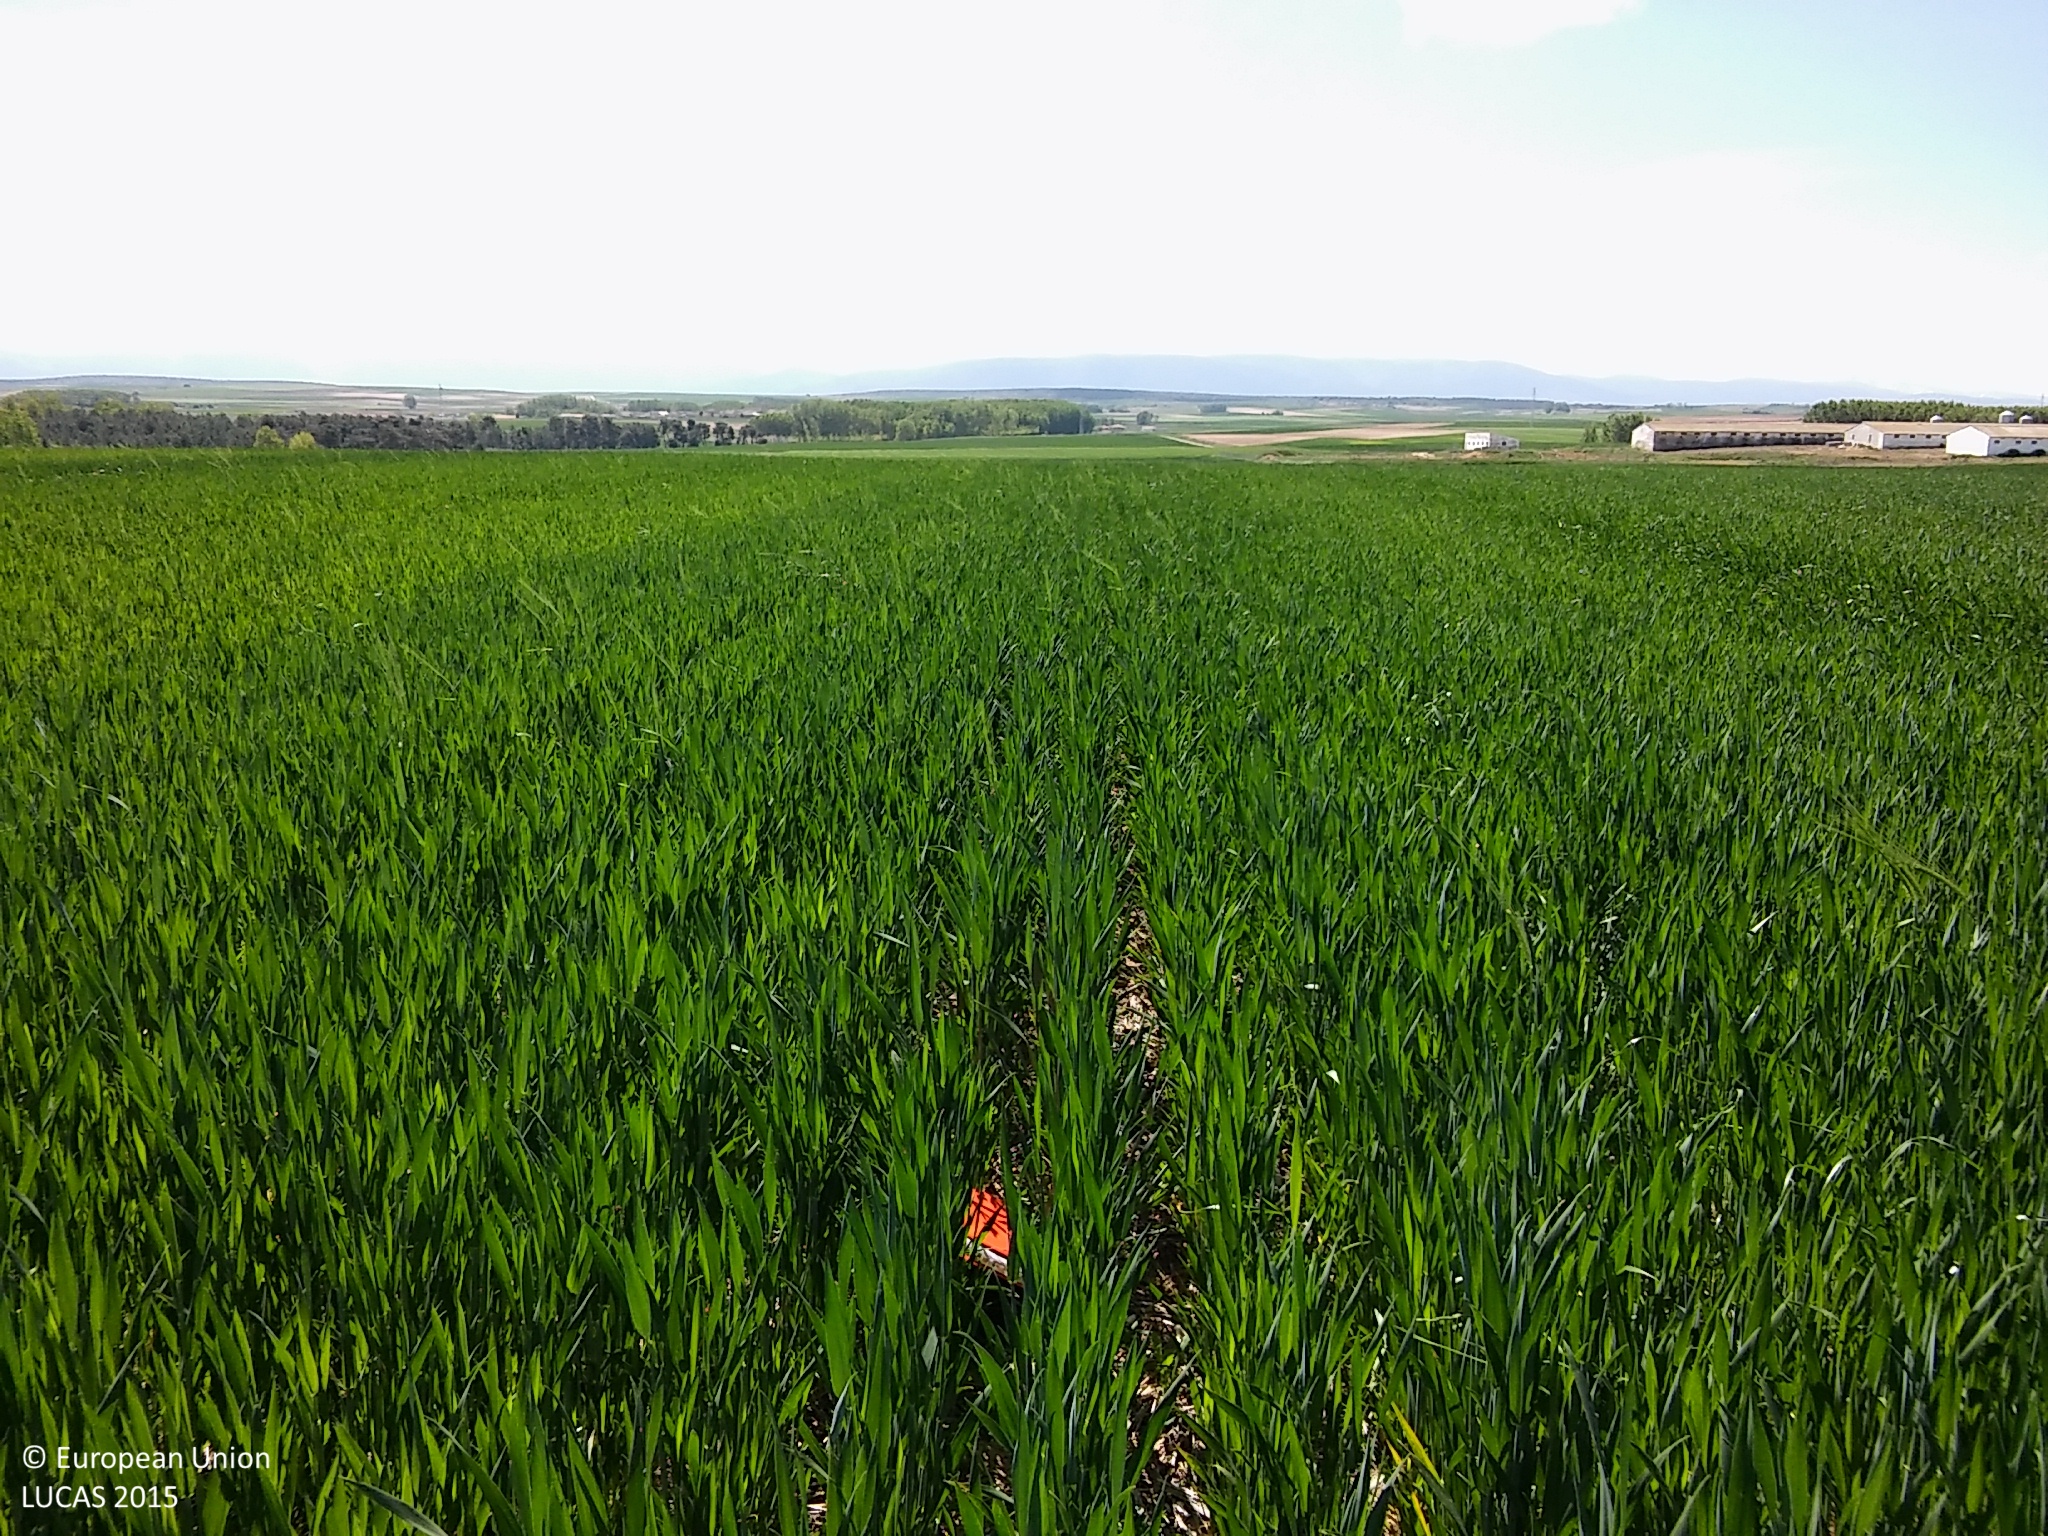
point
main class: Cropland
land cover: Common wheat
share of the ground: > 75 %
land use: Agriculture (excluding fallow land and kitchen gardens)
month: May
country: ES
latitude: 41.1870
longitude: -3.9643
